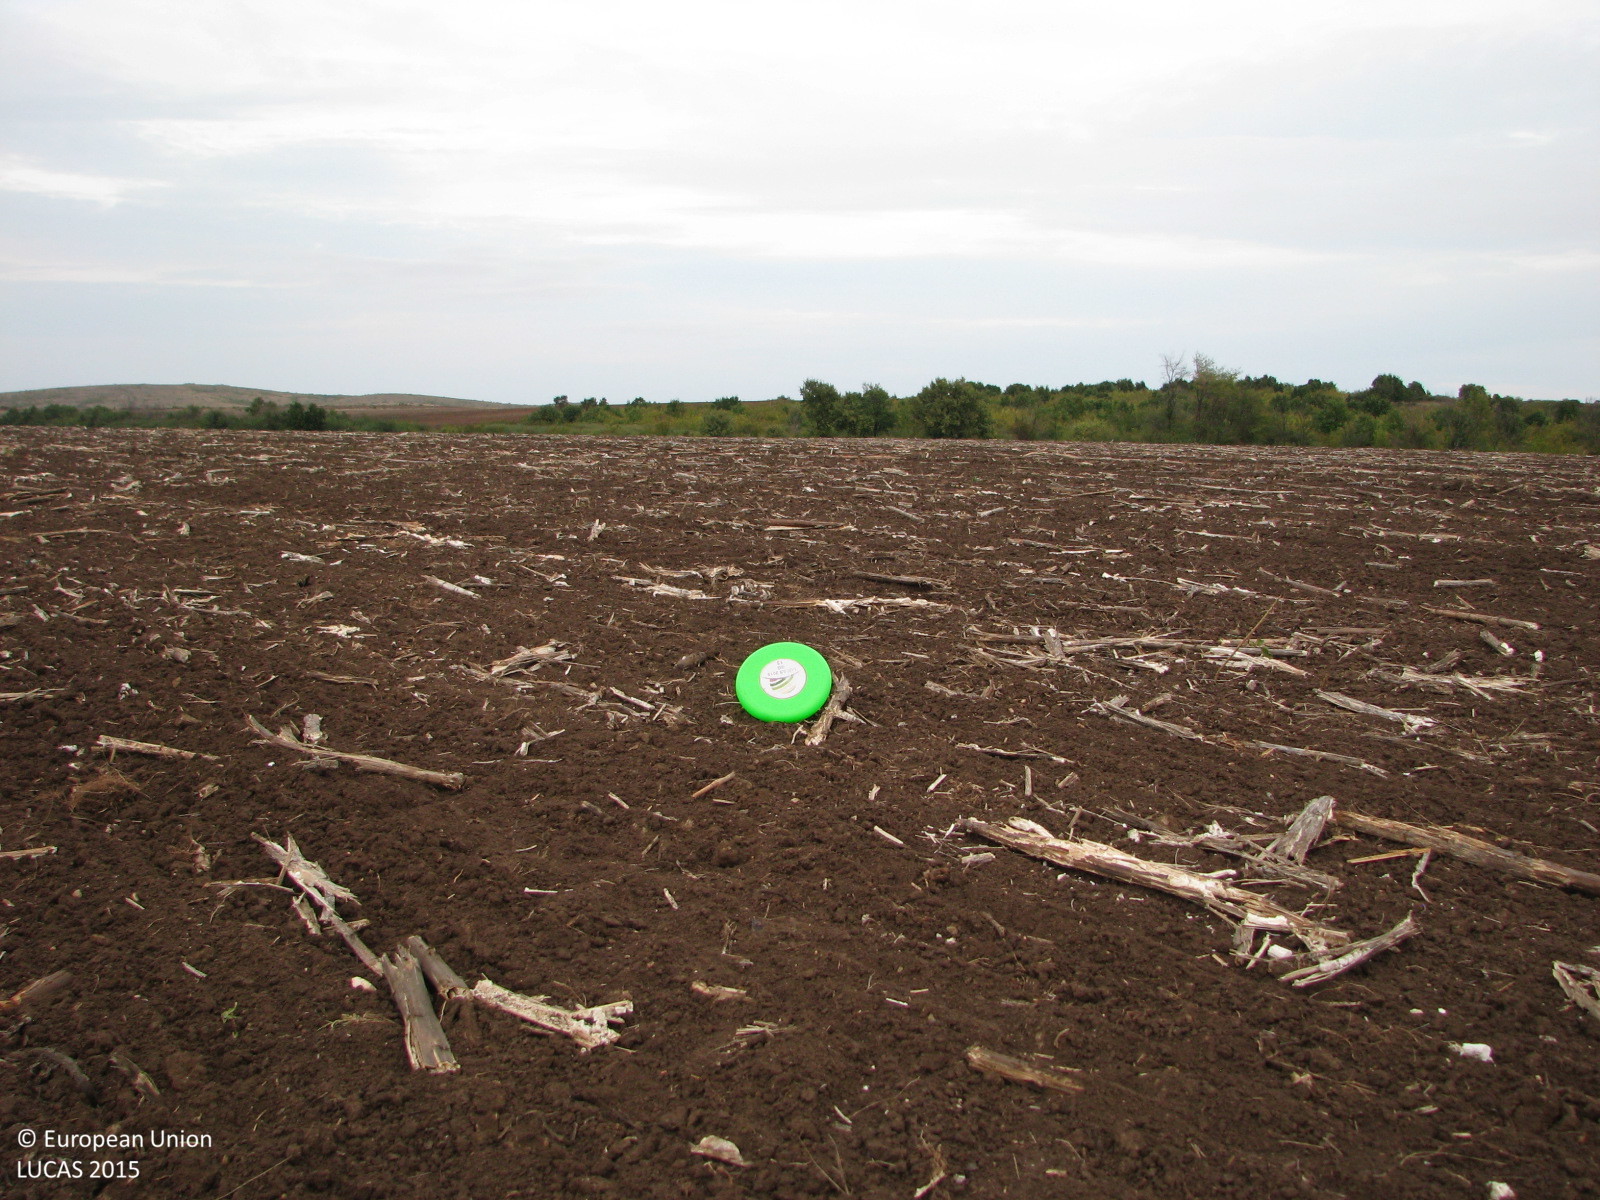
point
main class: Cropland
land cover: Sunflower
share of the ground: < 10 %
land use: Agriculture (excluding fallow land and kitchen gardens)
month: October
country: BG
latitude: 42.3909
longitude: 26.1788
